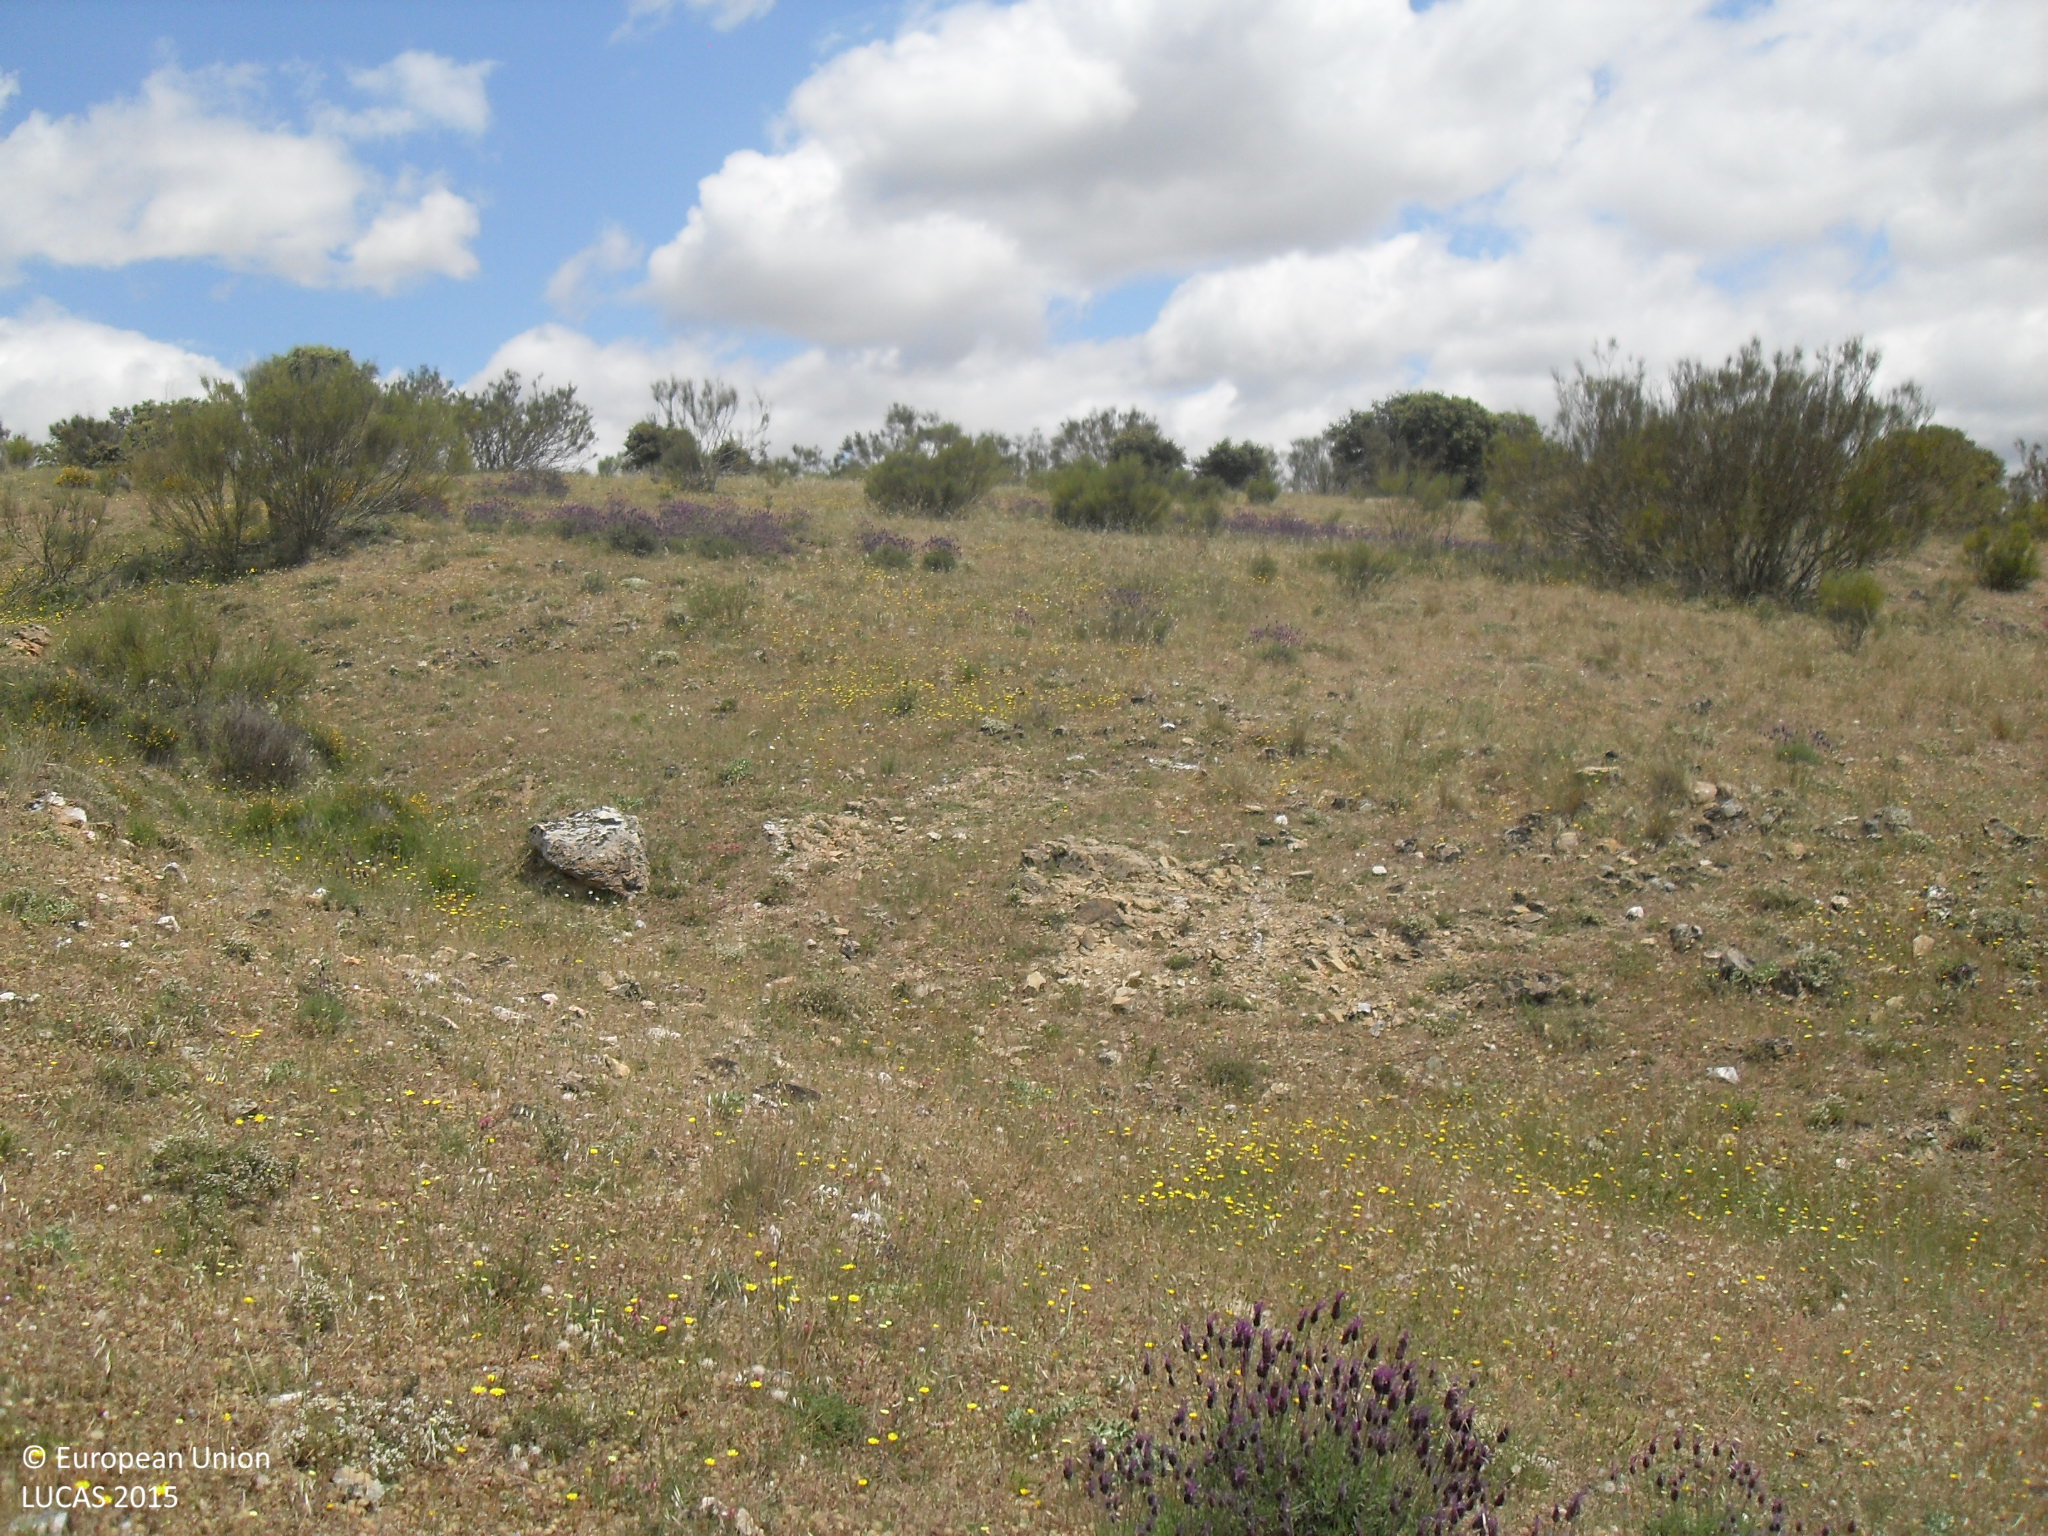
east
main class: Shrubland
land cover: Shrubland without tree cover
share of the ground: 10 - 25 %
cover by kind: herbaceous plants 80 %, shrubs 20 %
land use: Agriculture (excluding fallow land and kitchen gardens)
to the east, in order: Shrubland without tree cover; Tracks; Shrubland without tree cover; Tracks; Grass margins; Fences; Shrubland without tree cover
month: May
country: ES
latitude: 40.7531
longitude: -5.6251
